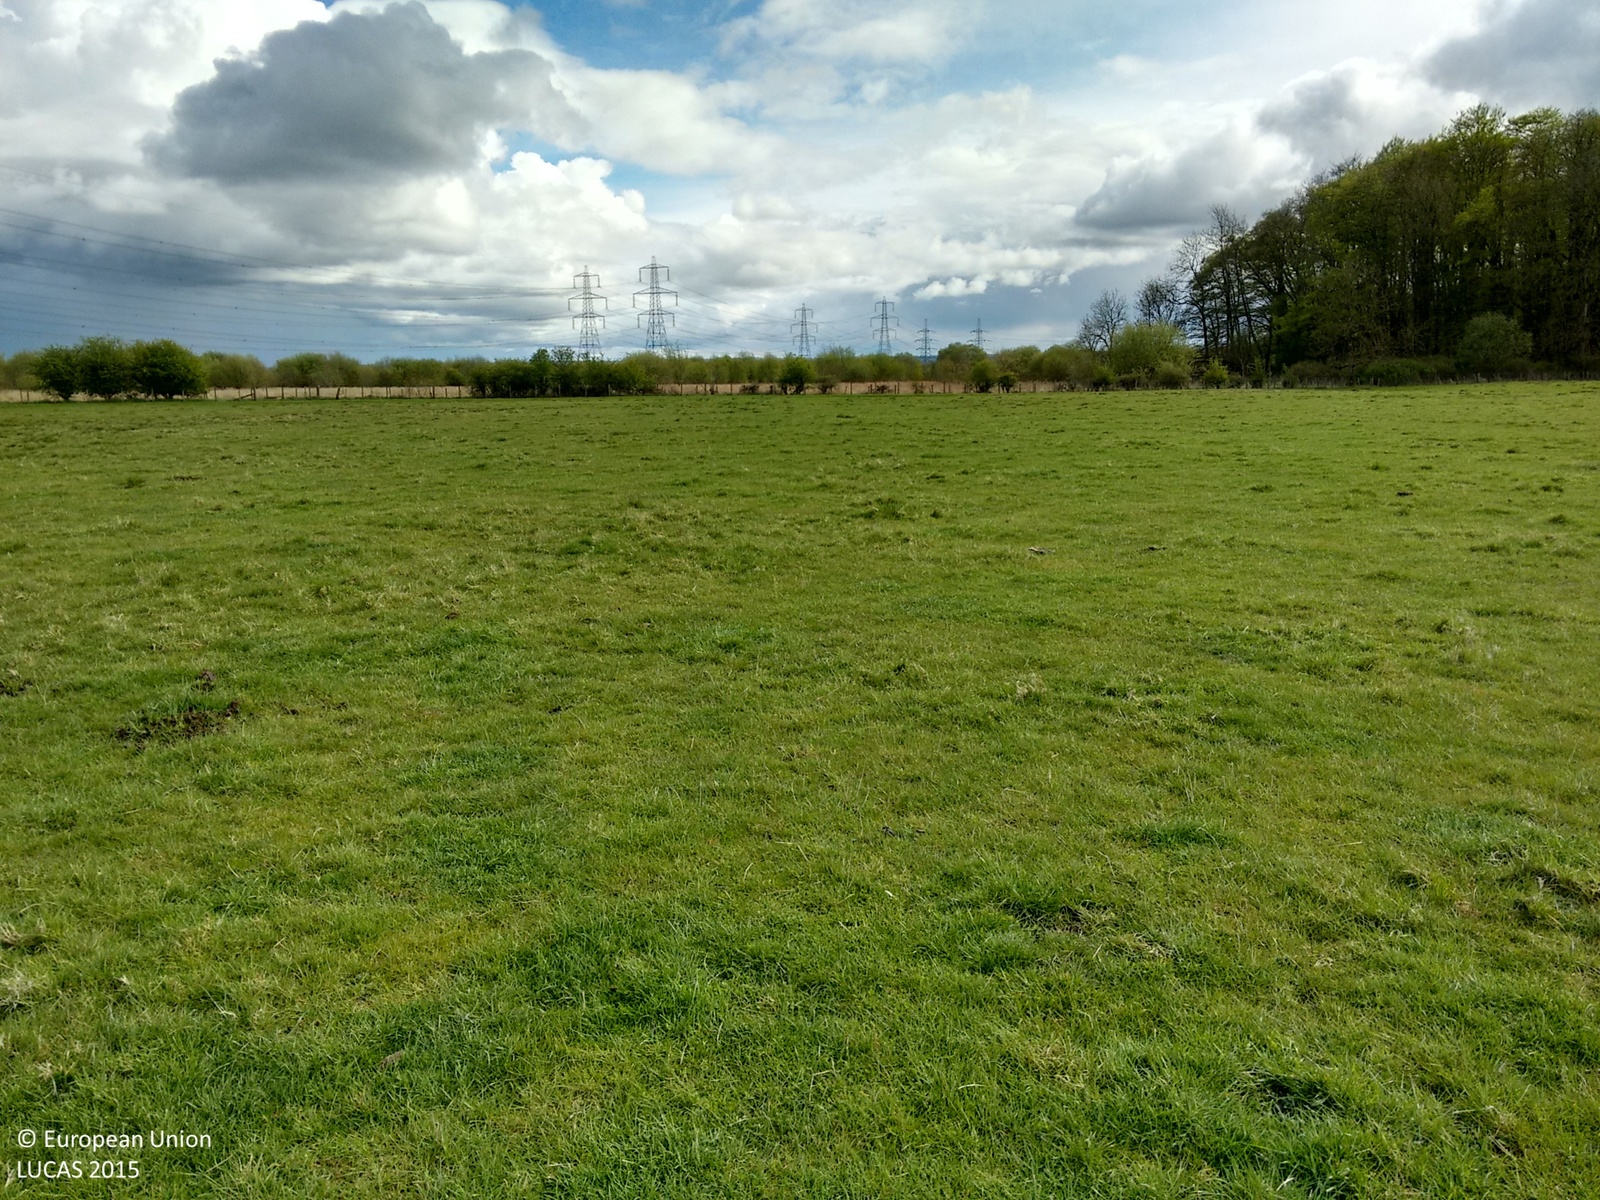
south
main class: Grassland
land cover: Grassland without tree/shrub cover
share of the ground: > 75 %
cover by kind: herbaceous plants 100 %
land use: Agriculture (excluding fallow land and kitchen gardens)
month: May
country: GB
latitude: 56.0747
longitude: -3.8194
